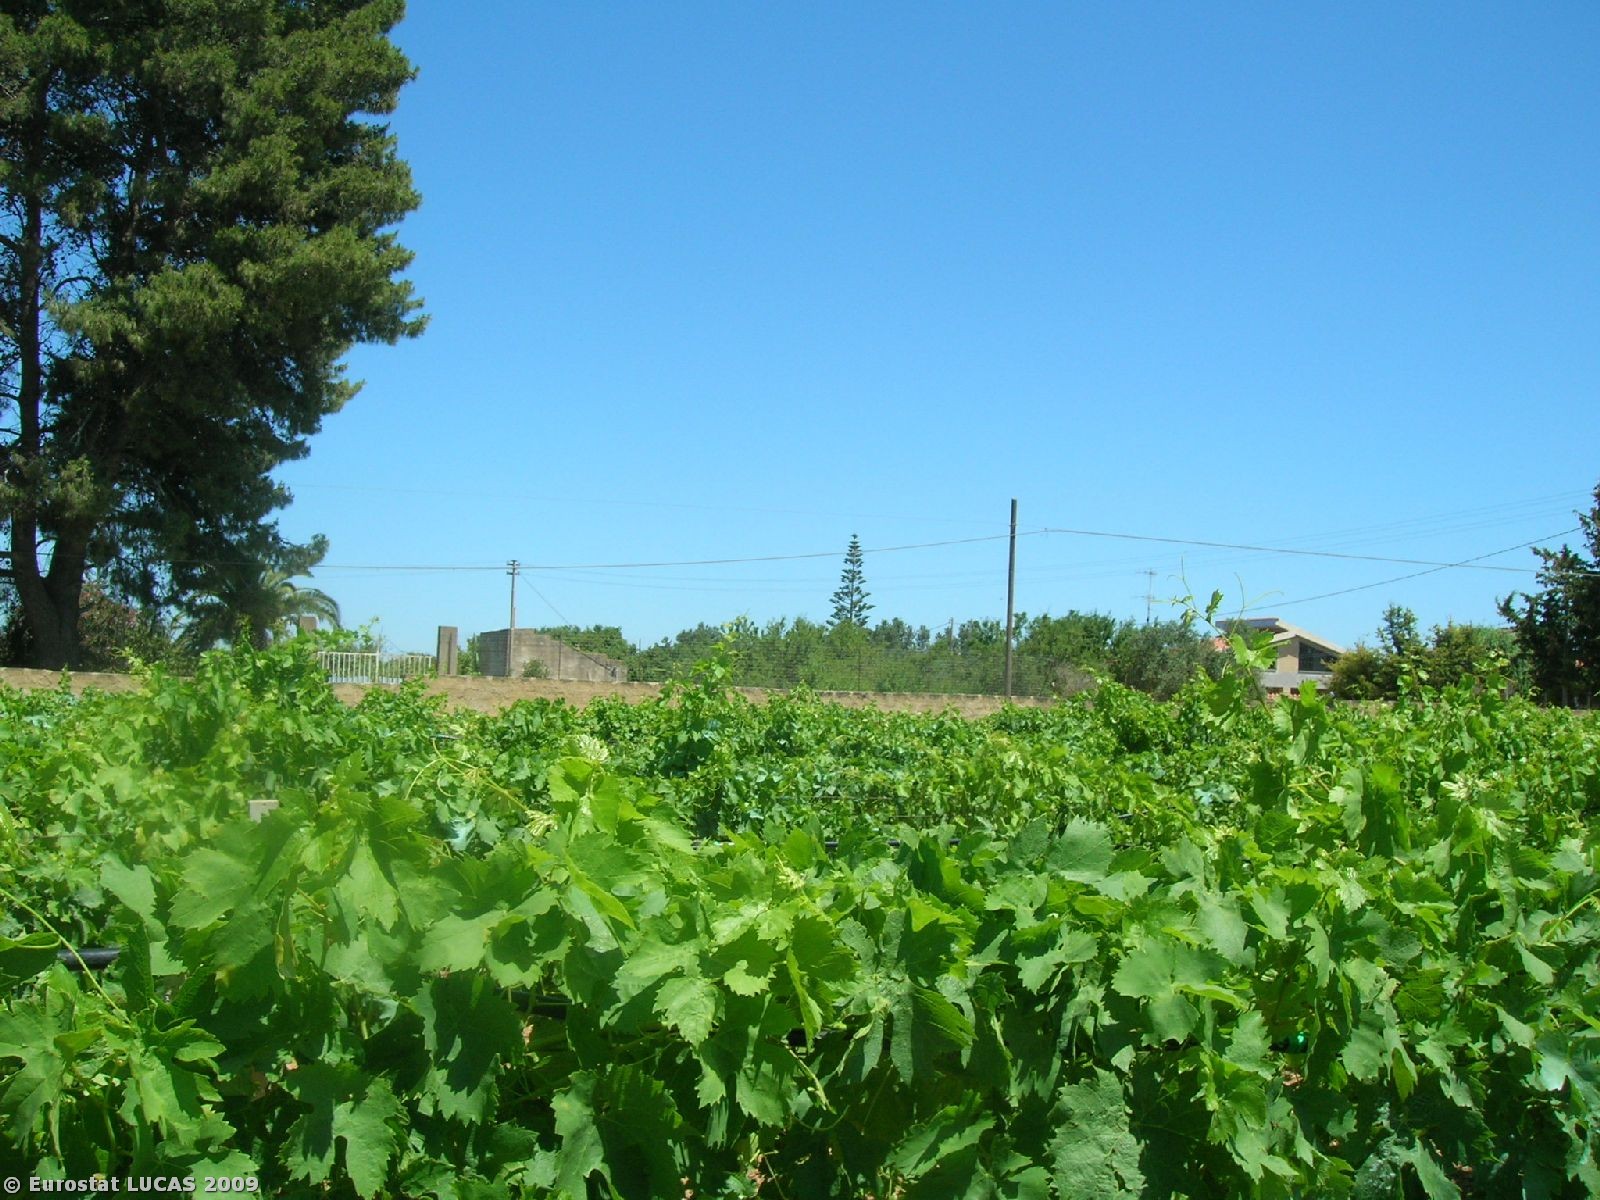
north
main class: Cropland
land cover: Vineyards
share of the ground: 50 - 75 %
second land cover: Bare land
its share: > 75 %
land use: Agriculture (excluding fallow land and kitchen gardens)
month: June
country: IT
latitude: 37.6570
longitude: 12.6212
